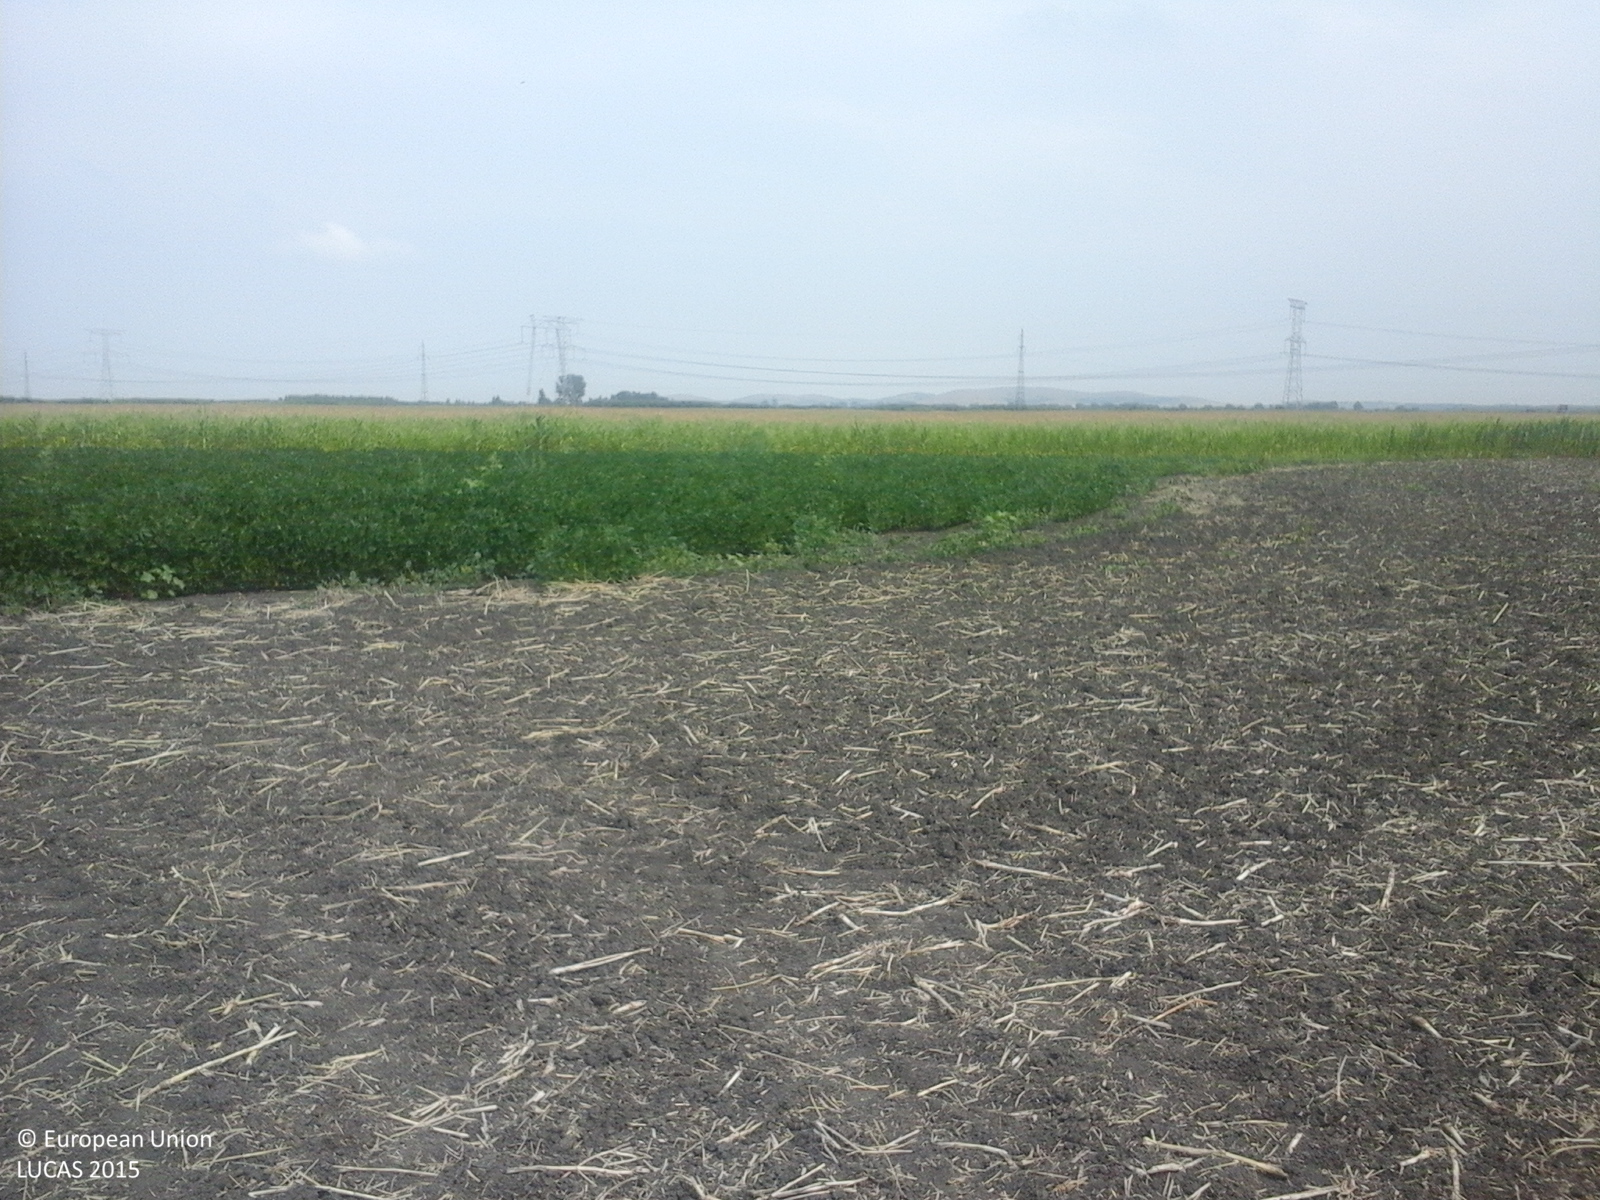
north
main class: Cropland
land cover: Rape and turnip rape
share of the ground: < 10 %
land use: Agriculture (excluding fallow land and kitchen gardens)
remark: Harvested field
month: July
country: RO
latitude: 45.3258
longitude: 28.0956
